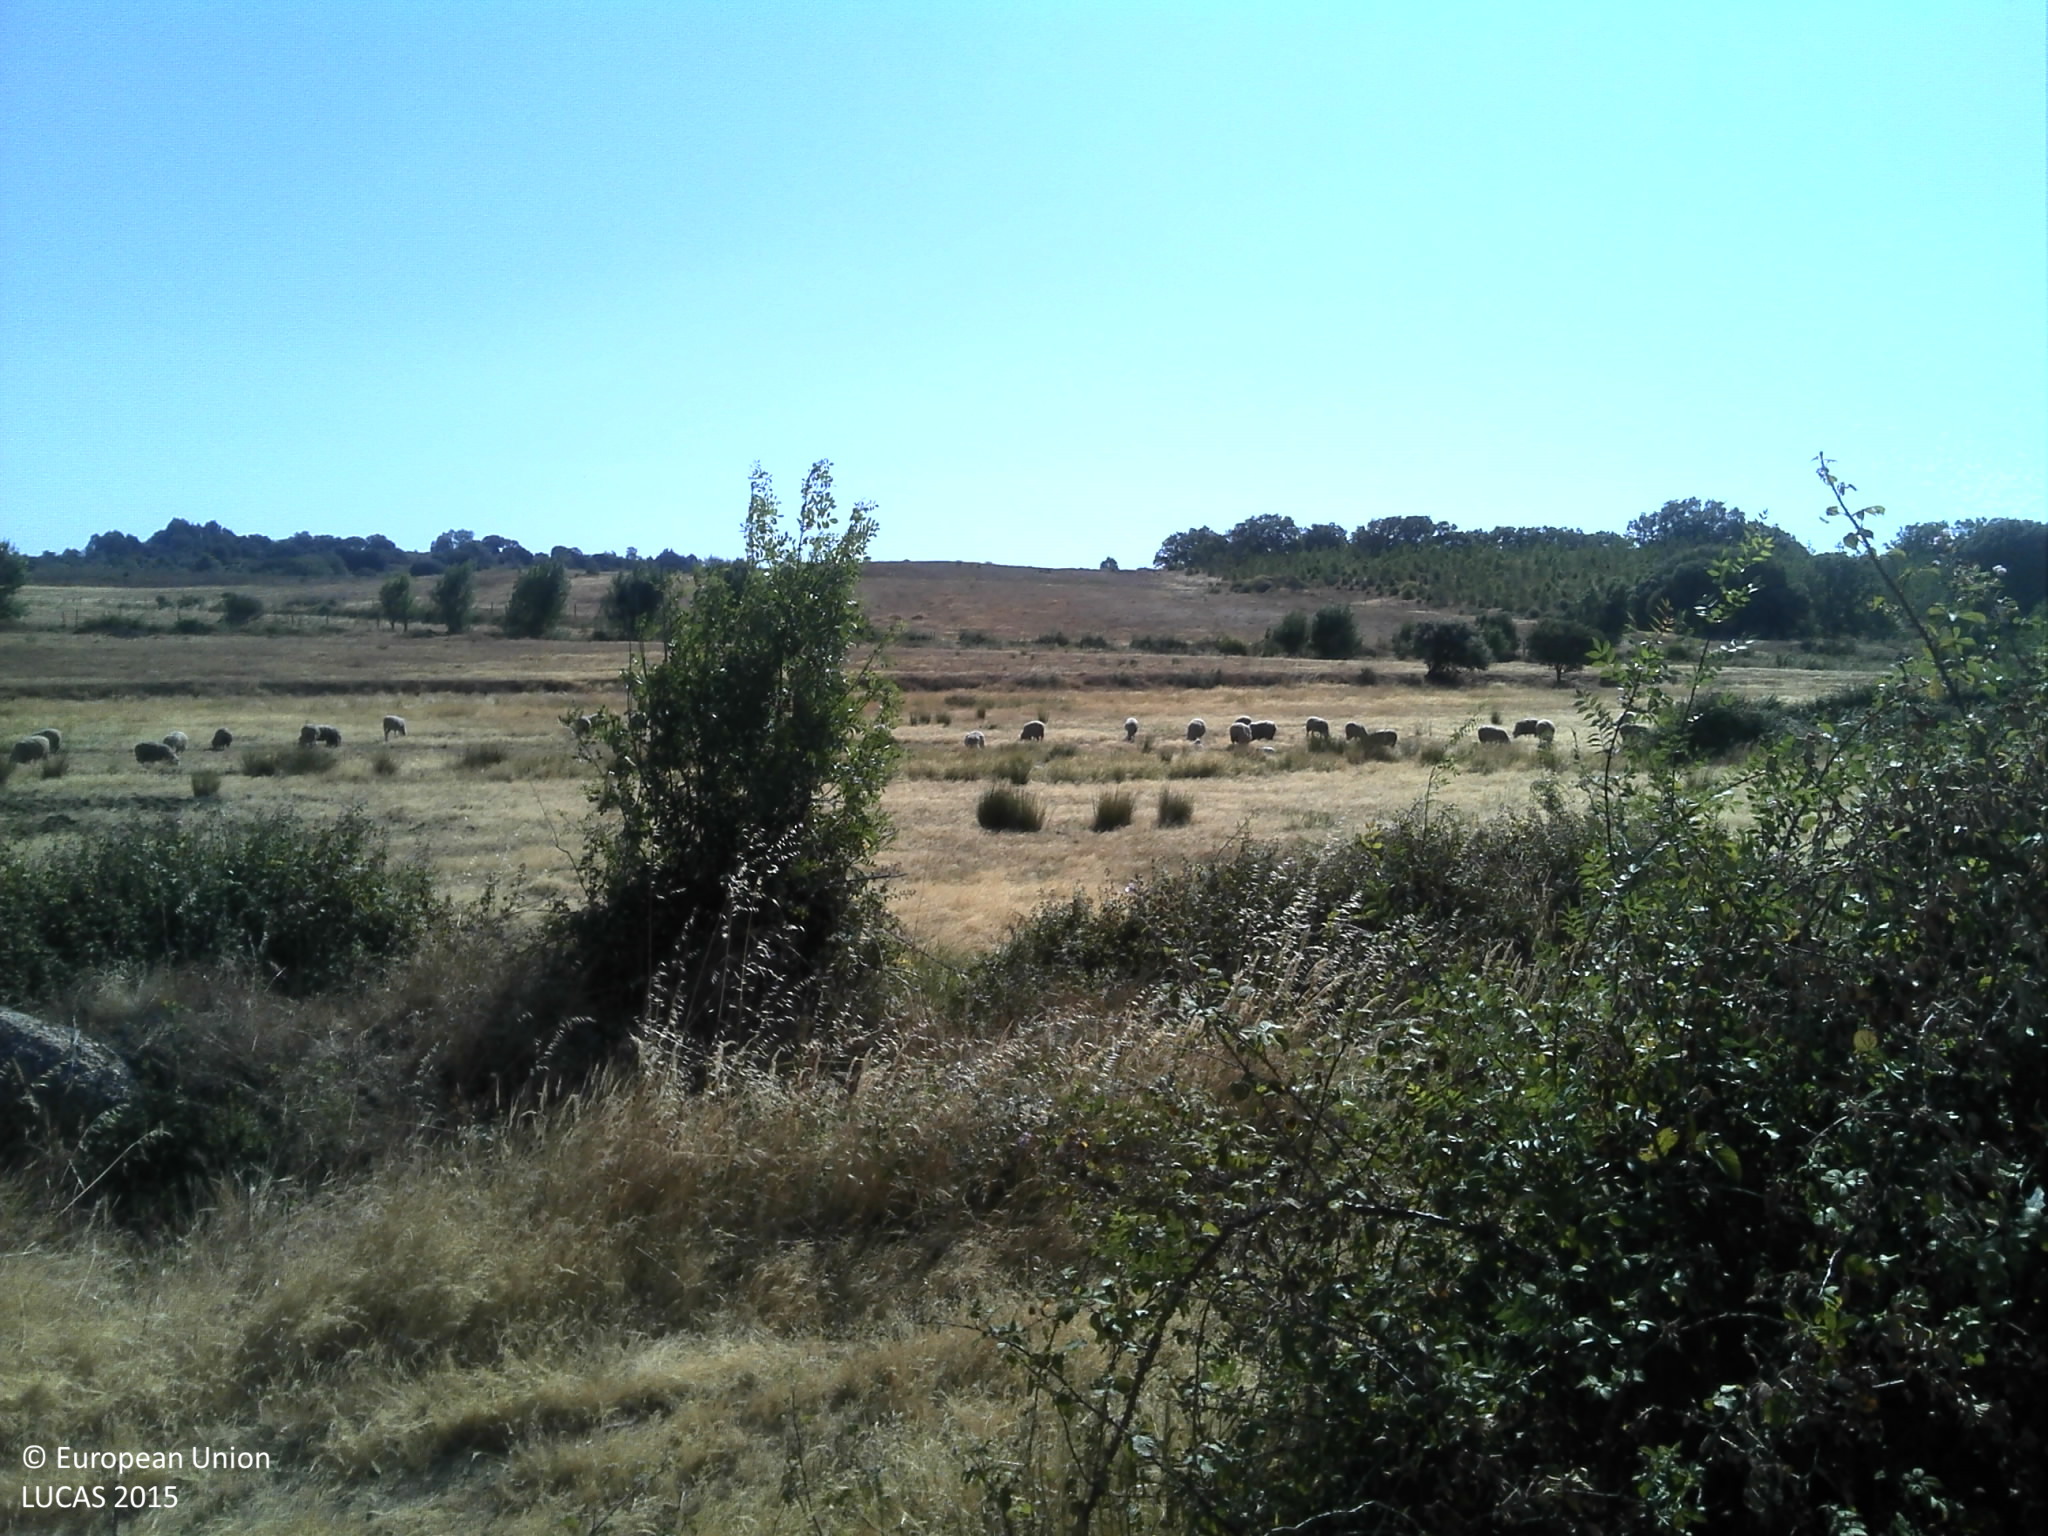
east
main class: Grassland
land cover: Grassland without tree/shrub cover
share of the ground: 50 - 75 %
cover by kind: herbaceous plants 60 %, unconsolidated bare surface 35 %
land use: Agriculture (excluding fallow land and kitchen gardens)
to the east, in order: Grassland without tree/shrub cover; Fences; Tracks; Rivers and streams; Grassland without tree/shrub cover; Single bushes/trees; Ditches and canals; Fences; Grassland without tree/shrub cover; Fences; Shrubland with sparse tree cover; Grassland without tree/shrub cover; Pine dominated coniferous woodland
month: June
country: PT
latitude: 40.0739
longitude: -7.3488
